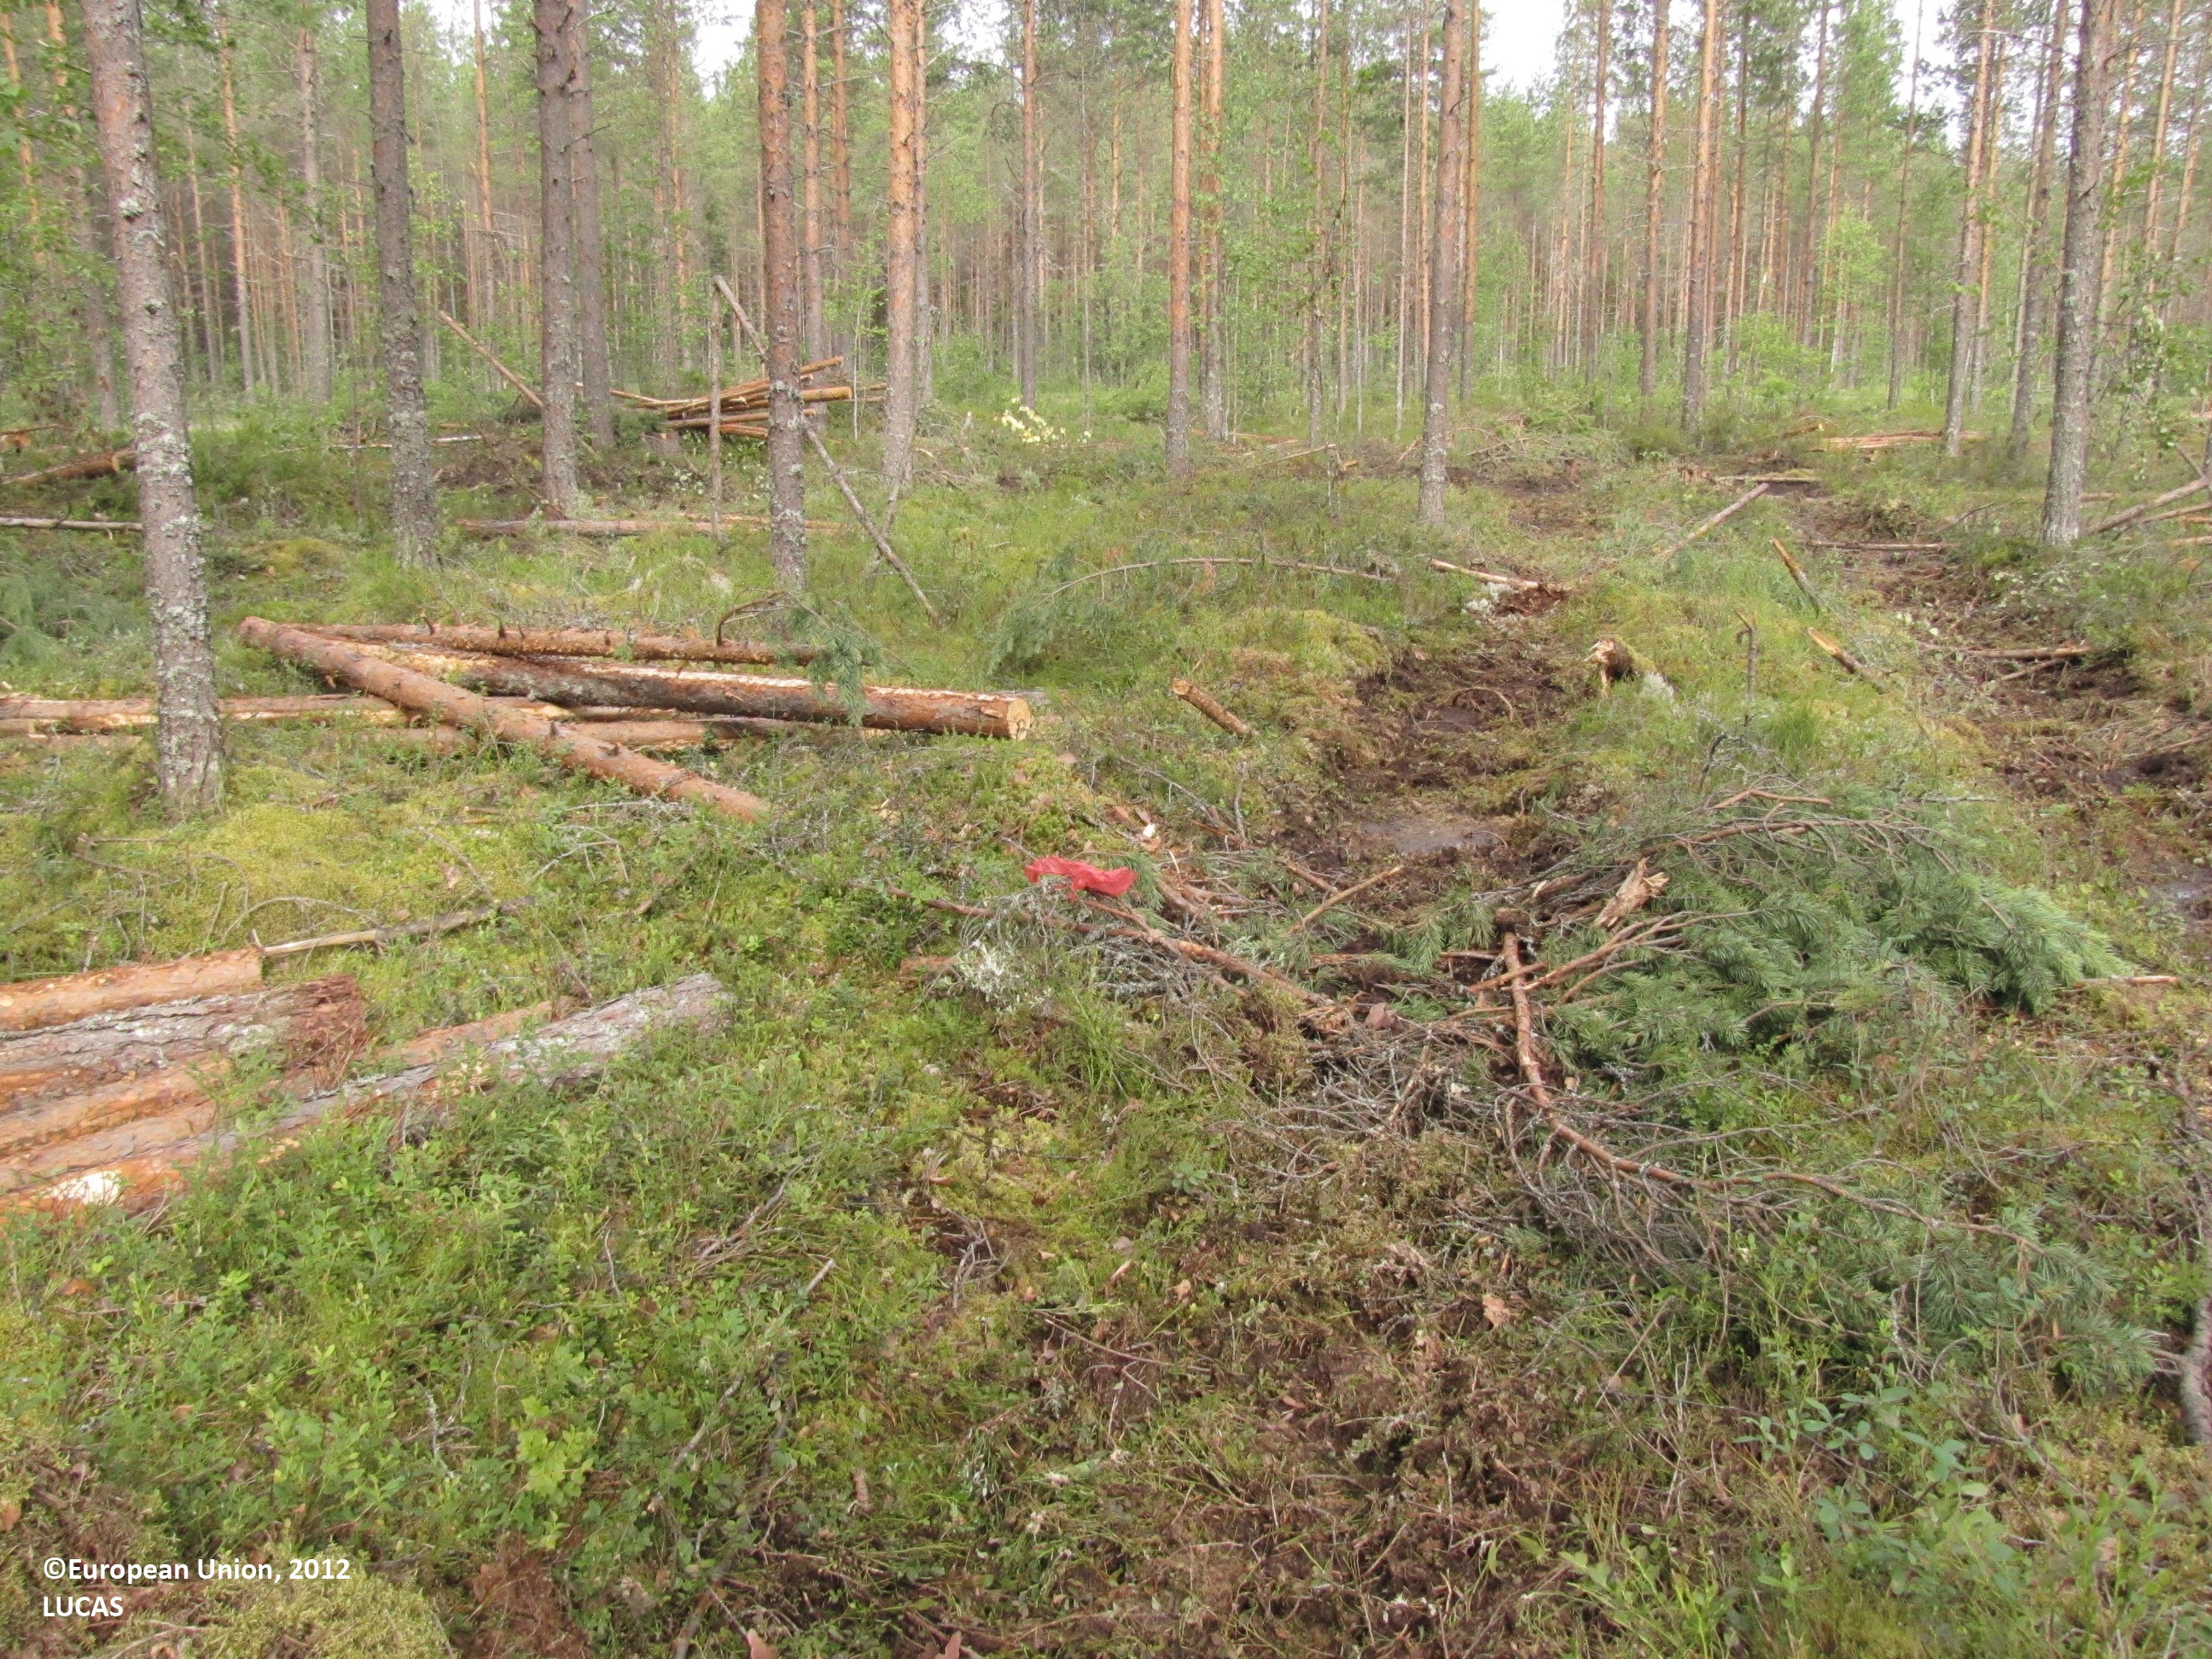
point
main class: Woodland
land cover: Pine dominated coniferous woodland
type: mire and swamp forests
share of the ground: 50 - 75 %
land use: Forestry
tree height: > 5 m
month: July
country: FI
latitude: 62.3700
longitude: 23.2698
